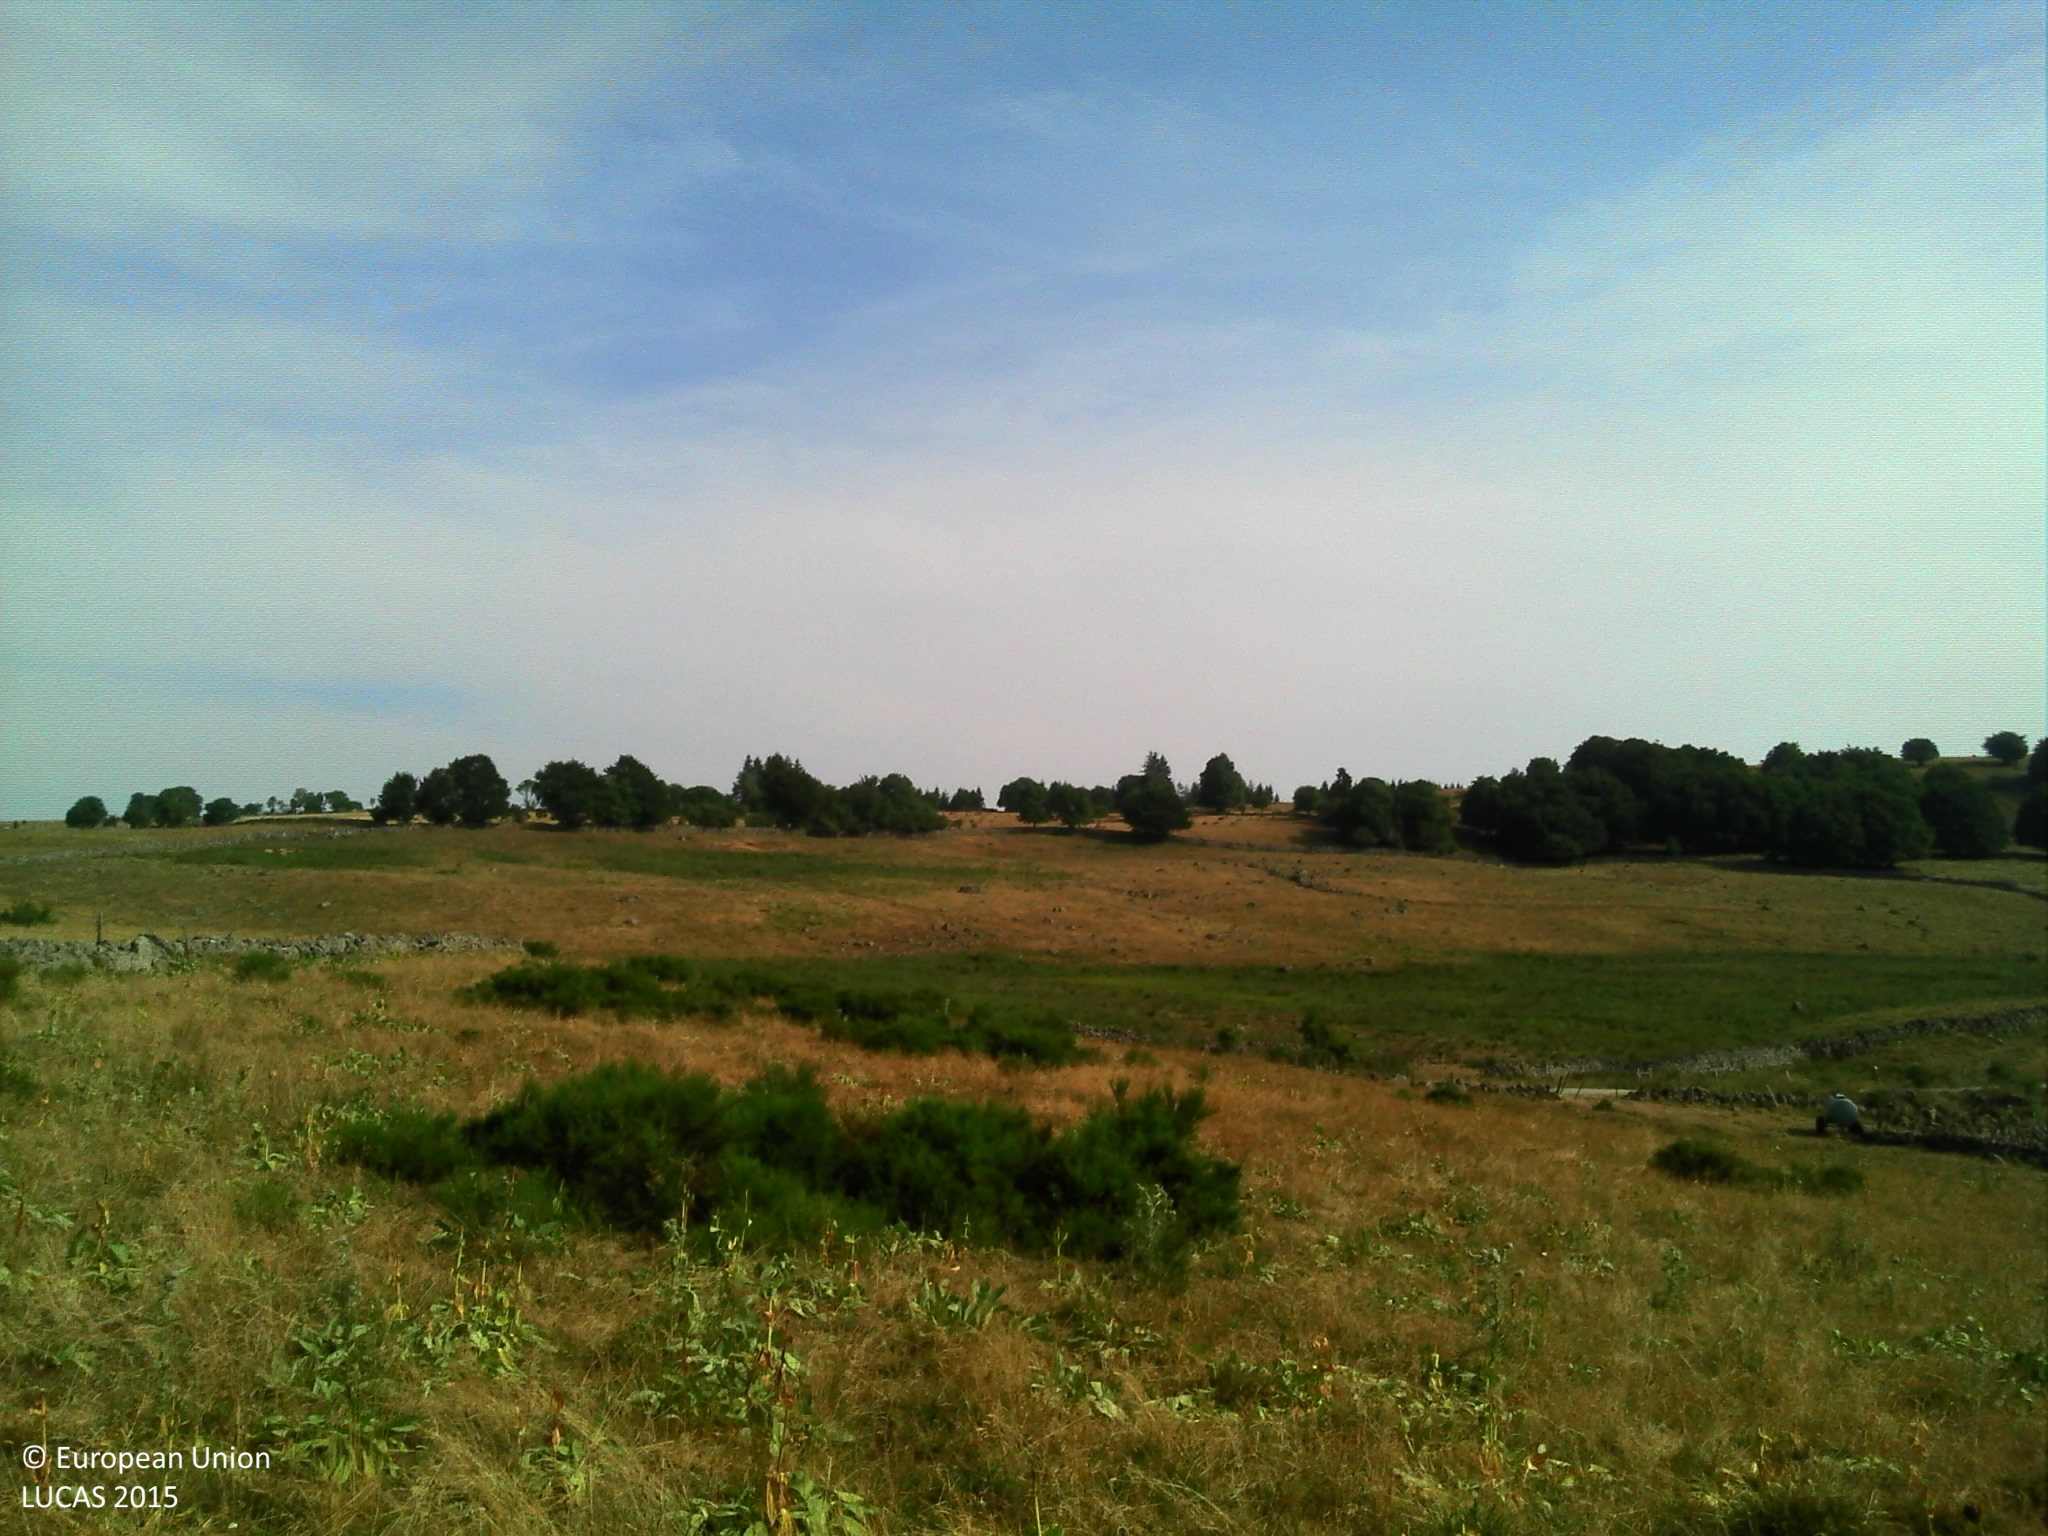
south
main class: Grassland
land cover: Grassland without tree/shrub cover
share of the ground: > 75 %
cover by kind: herbaceous plants 95 %, shrubs 5 %
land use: Agriculture (excluding fallow land and kitchen gardens)
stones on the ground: 10 - 25 %
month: July
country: FR
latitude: 44.6589
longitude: 3.0295
